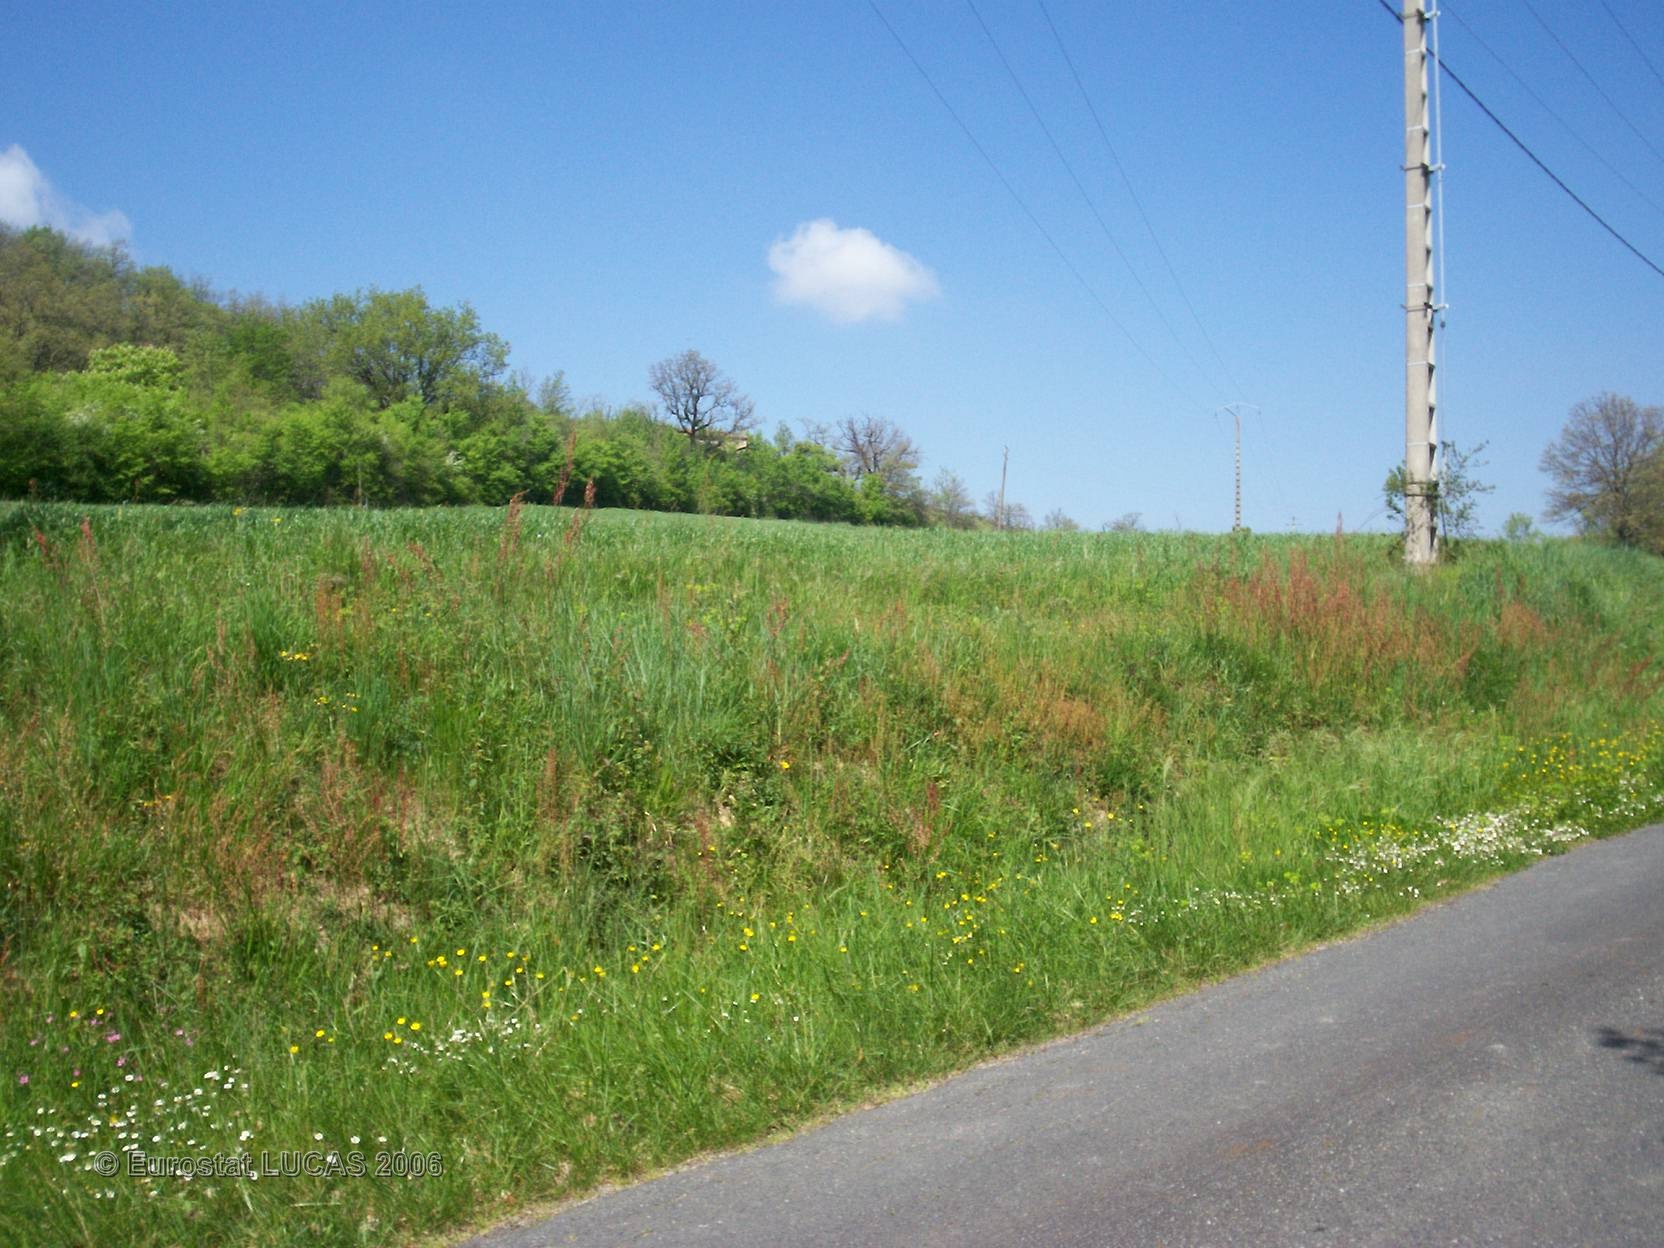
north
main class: Woodland
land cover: Broadleaved forest
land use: Forestry
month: April
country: FR
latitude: 43.6812
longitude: 2.0284
